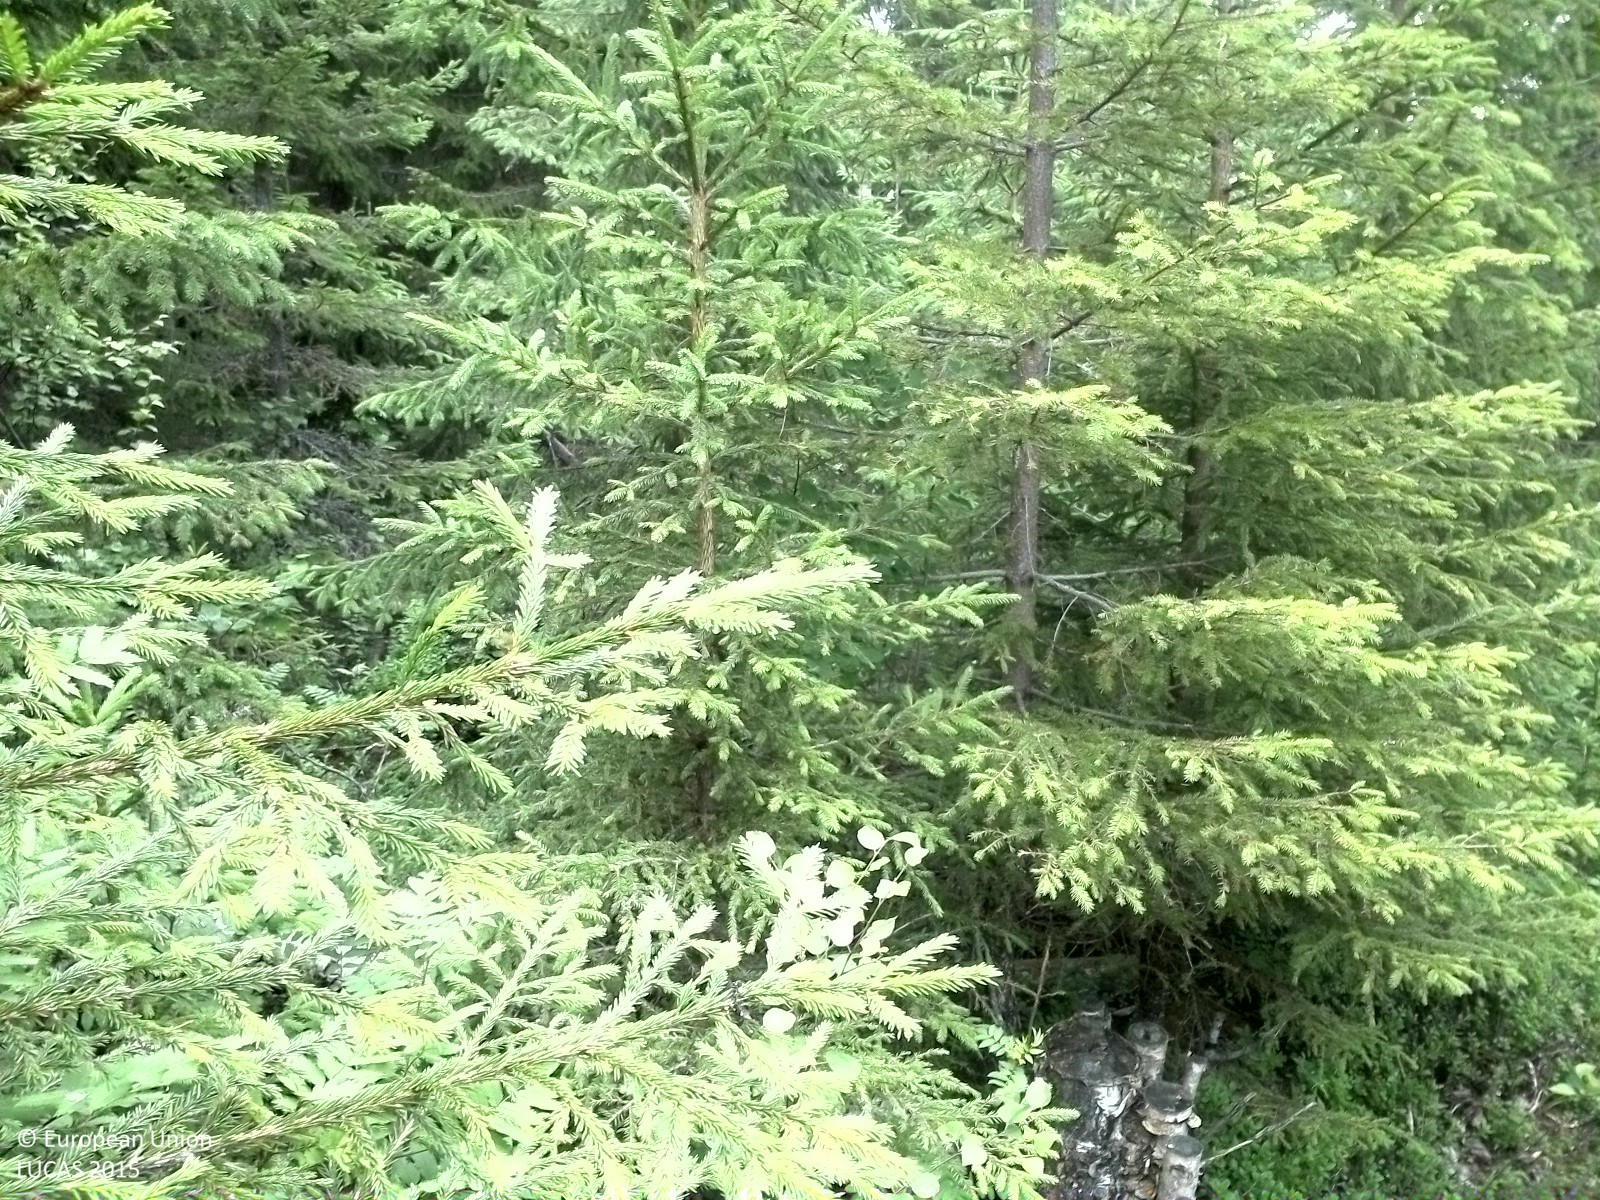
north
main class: Woodland
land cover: Spruce dominated coniferous woodland
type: boreal forest
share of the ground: 50 - 75 %
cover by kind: coniferous forest trees 60 %, shrubs 40 %
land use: Forestry
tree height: < 5 m
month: August
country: SE
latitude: 62.5564
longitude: 17.0393
